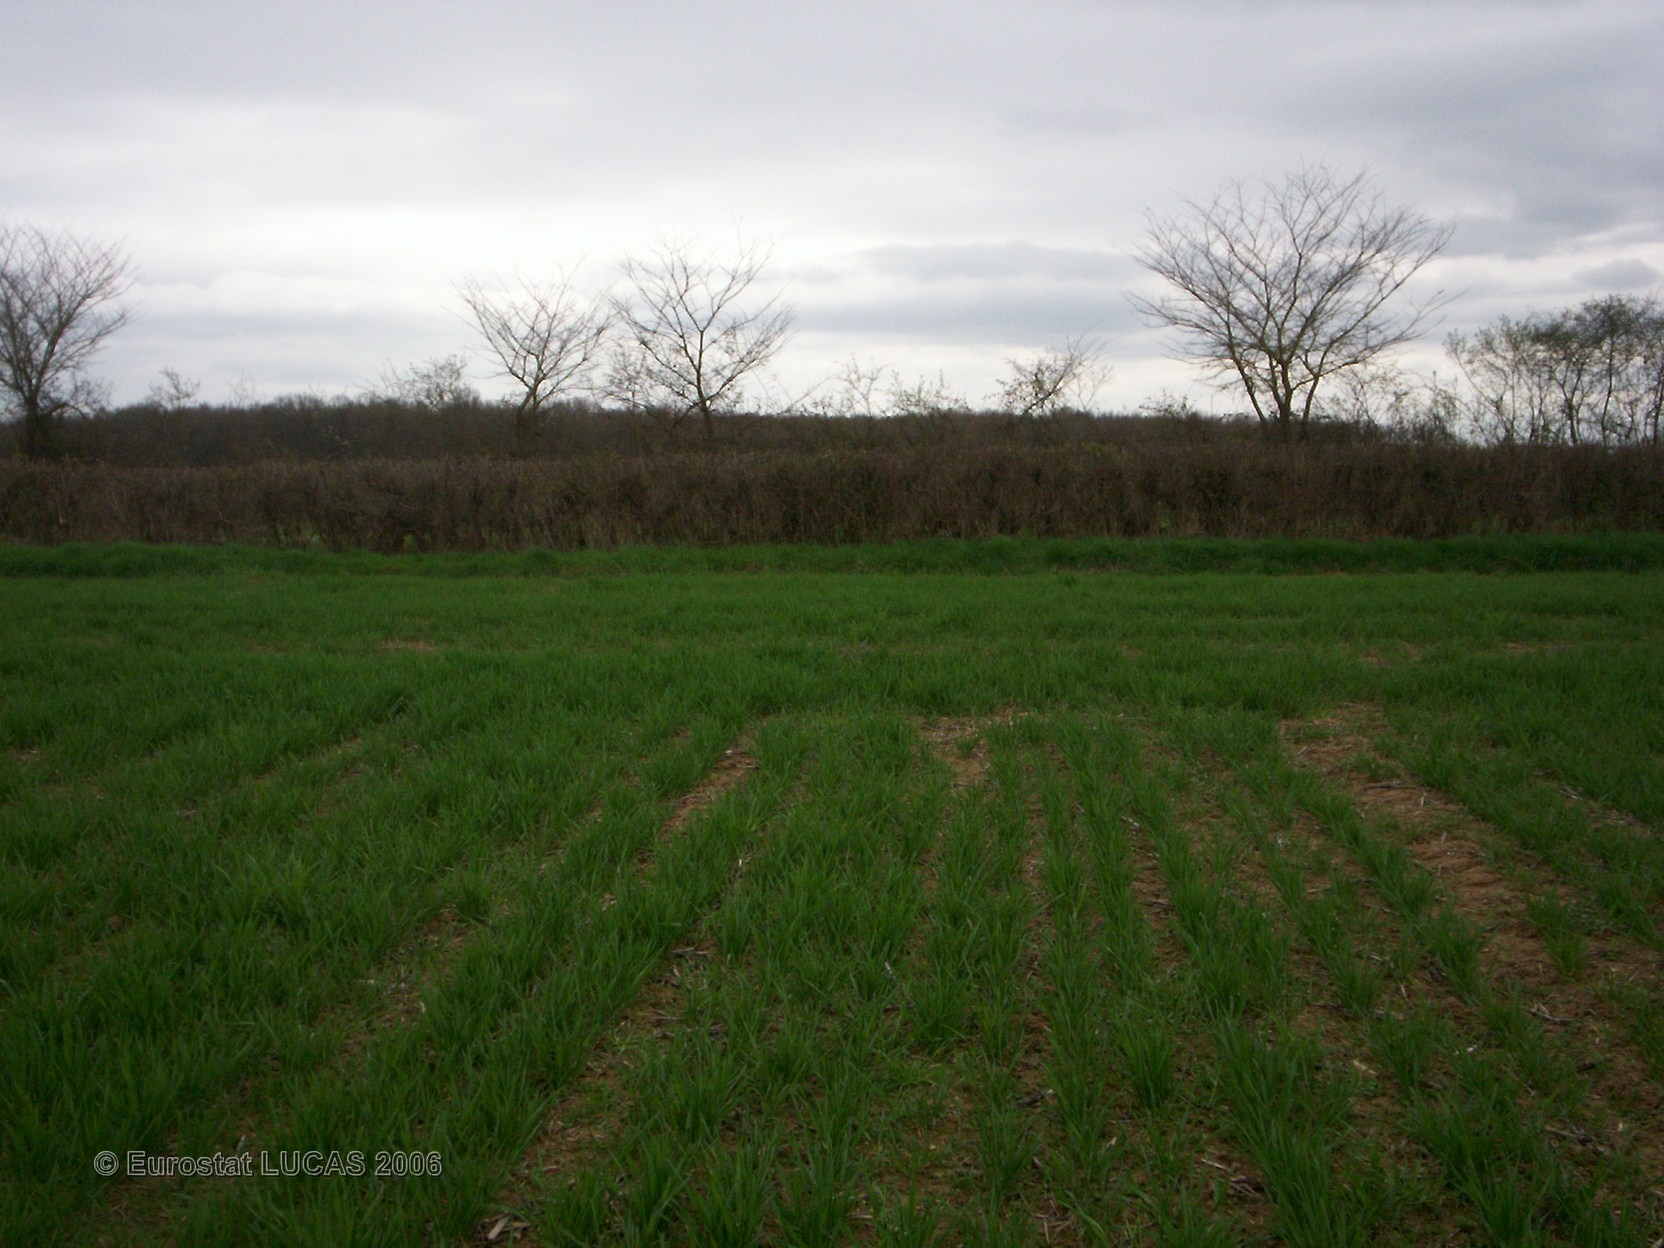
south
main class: Cropland
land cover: Common wheat
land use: Agriculture (excluding fallow land and kitchen gardens)
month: April
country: FR
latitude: 46.7214
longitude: 3.0494
